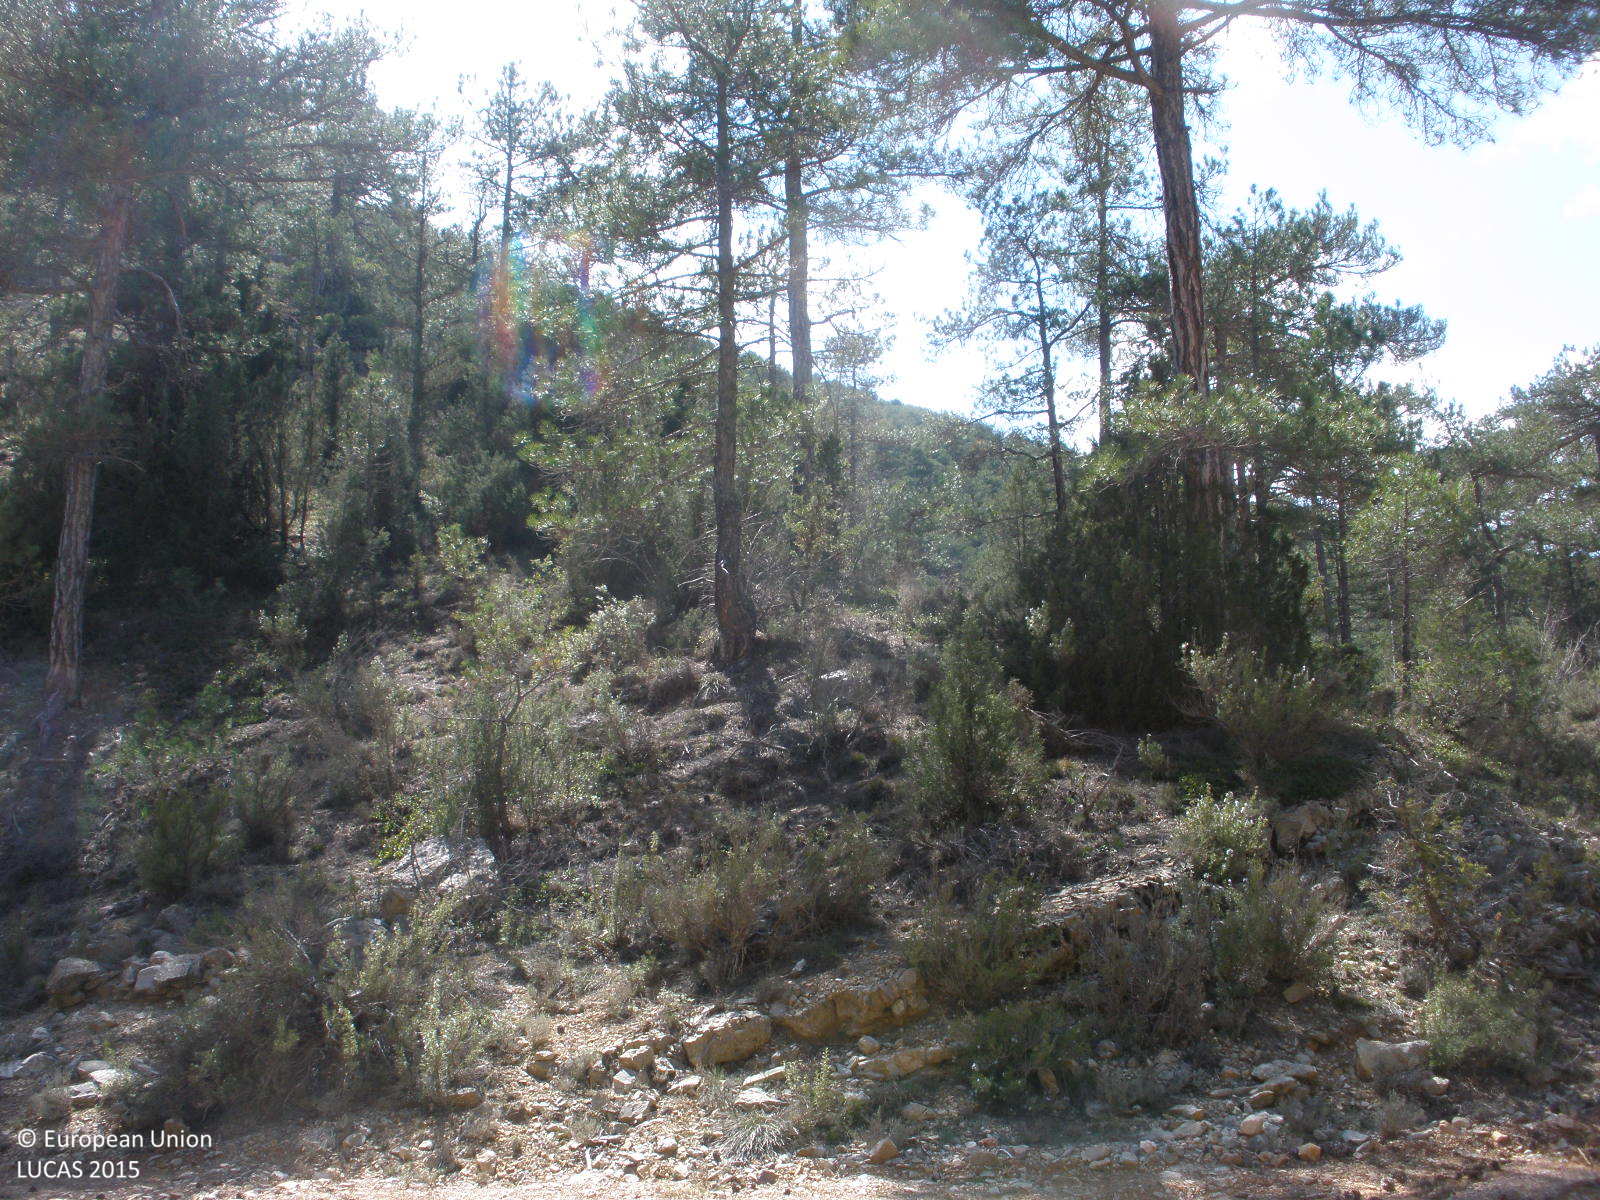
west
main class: Woodland
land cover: Pine dominated coniferous woodland
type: coniferous forest of the mediterranean region
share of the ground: 25 - 50 %
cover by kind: coniferous forest trees 40 %, shrubs 40 %, consolidated bare surface 20 %
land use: Semi-natural and natural areas not in use
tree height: > 5 m
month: April
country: ES
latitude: 40.2760
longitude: -1.2424
